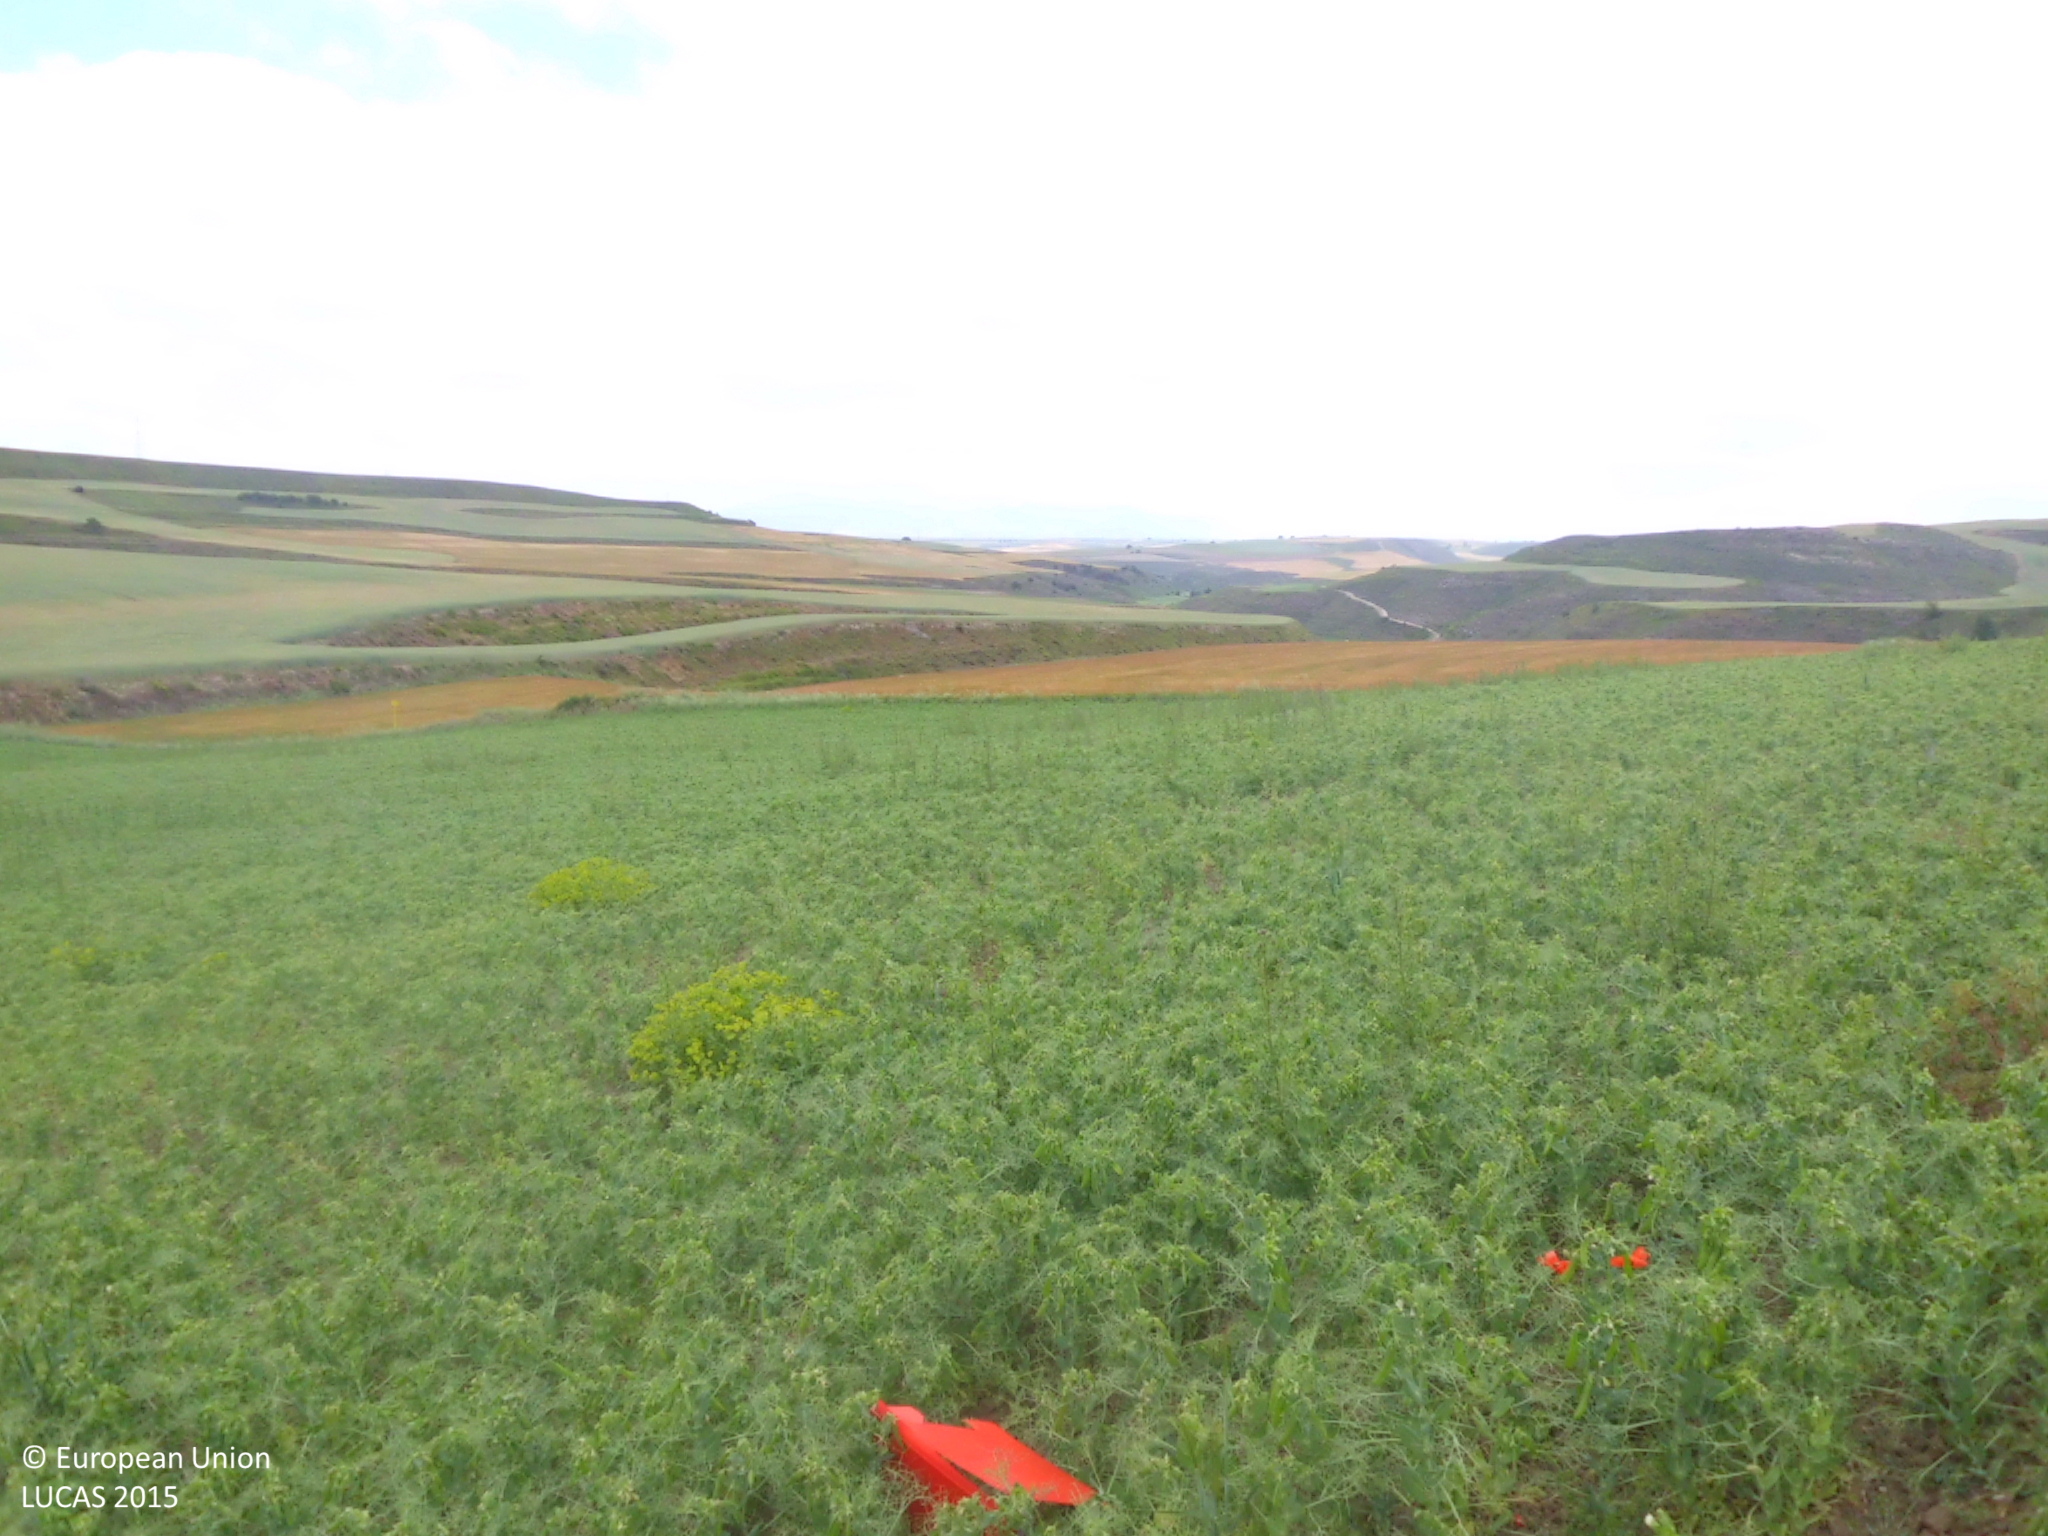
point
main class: Cropland
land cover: Dry pulses
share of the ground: > 75 %
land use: Agriculture (excluding fallow land and kitchen gardens)
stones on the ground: < 10 %
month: June
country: ES
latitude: 42.4993
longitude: -3.3325
